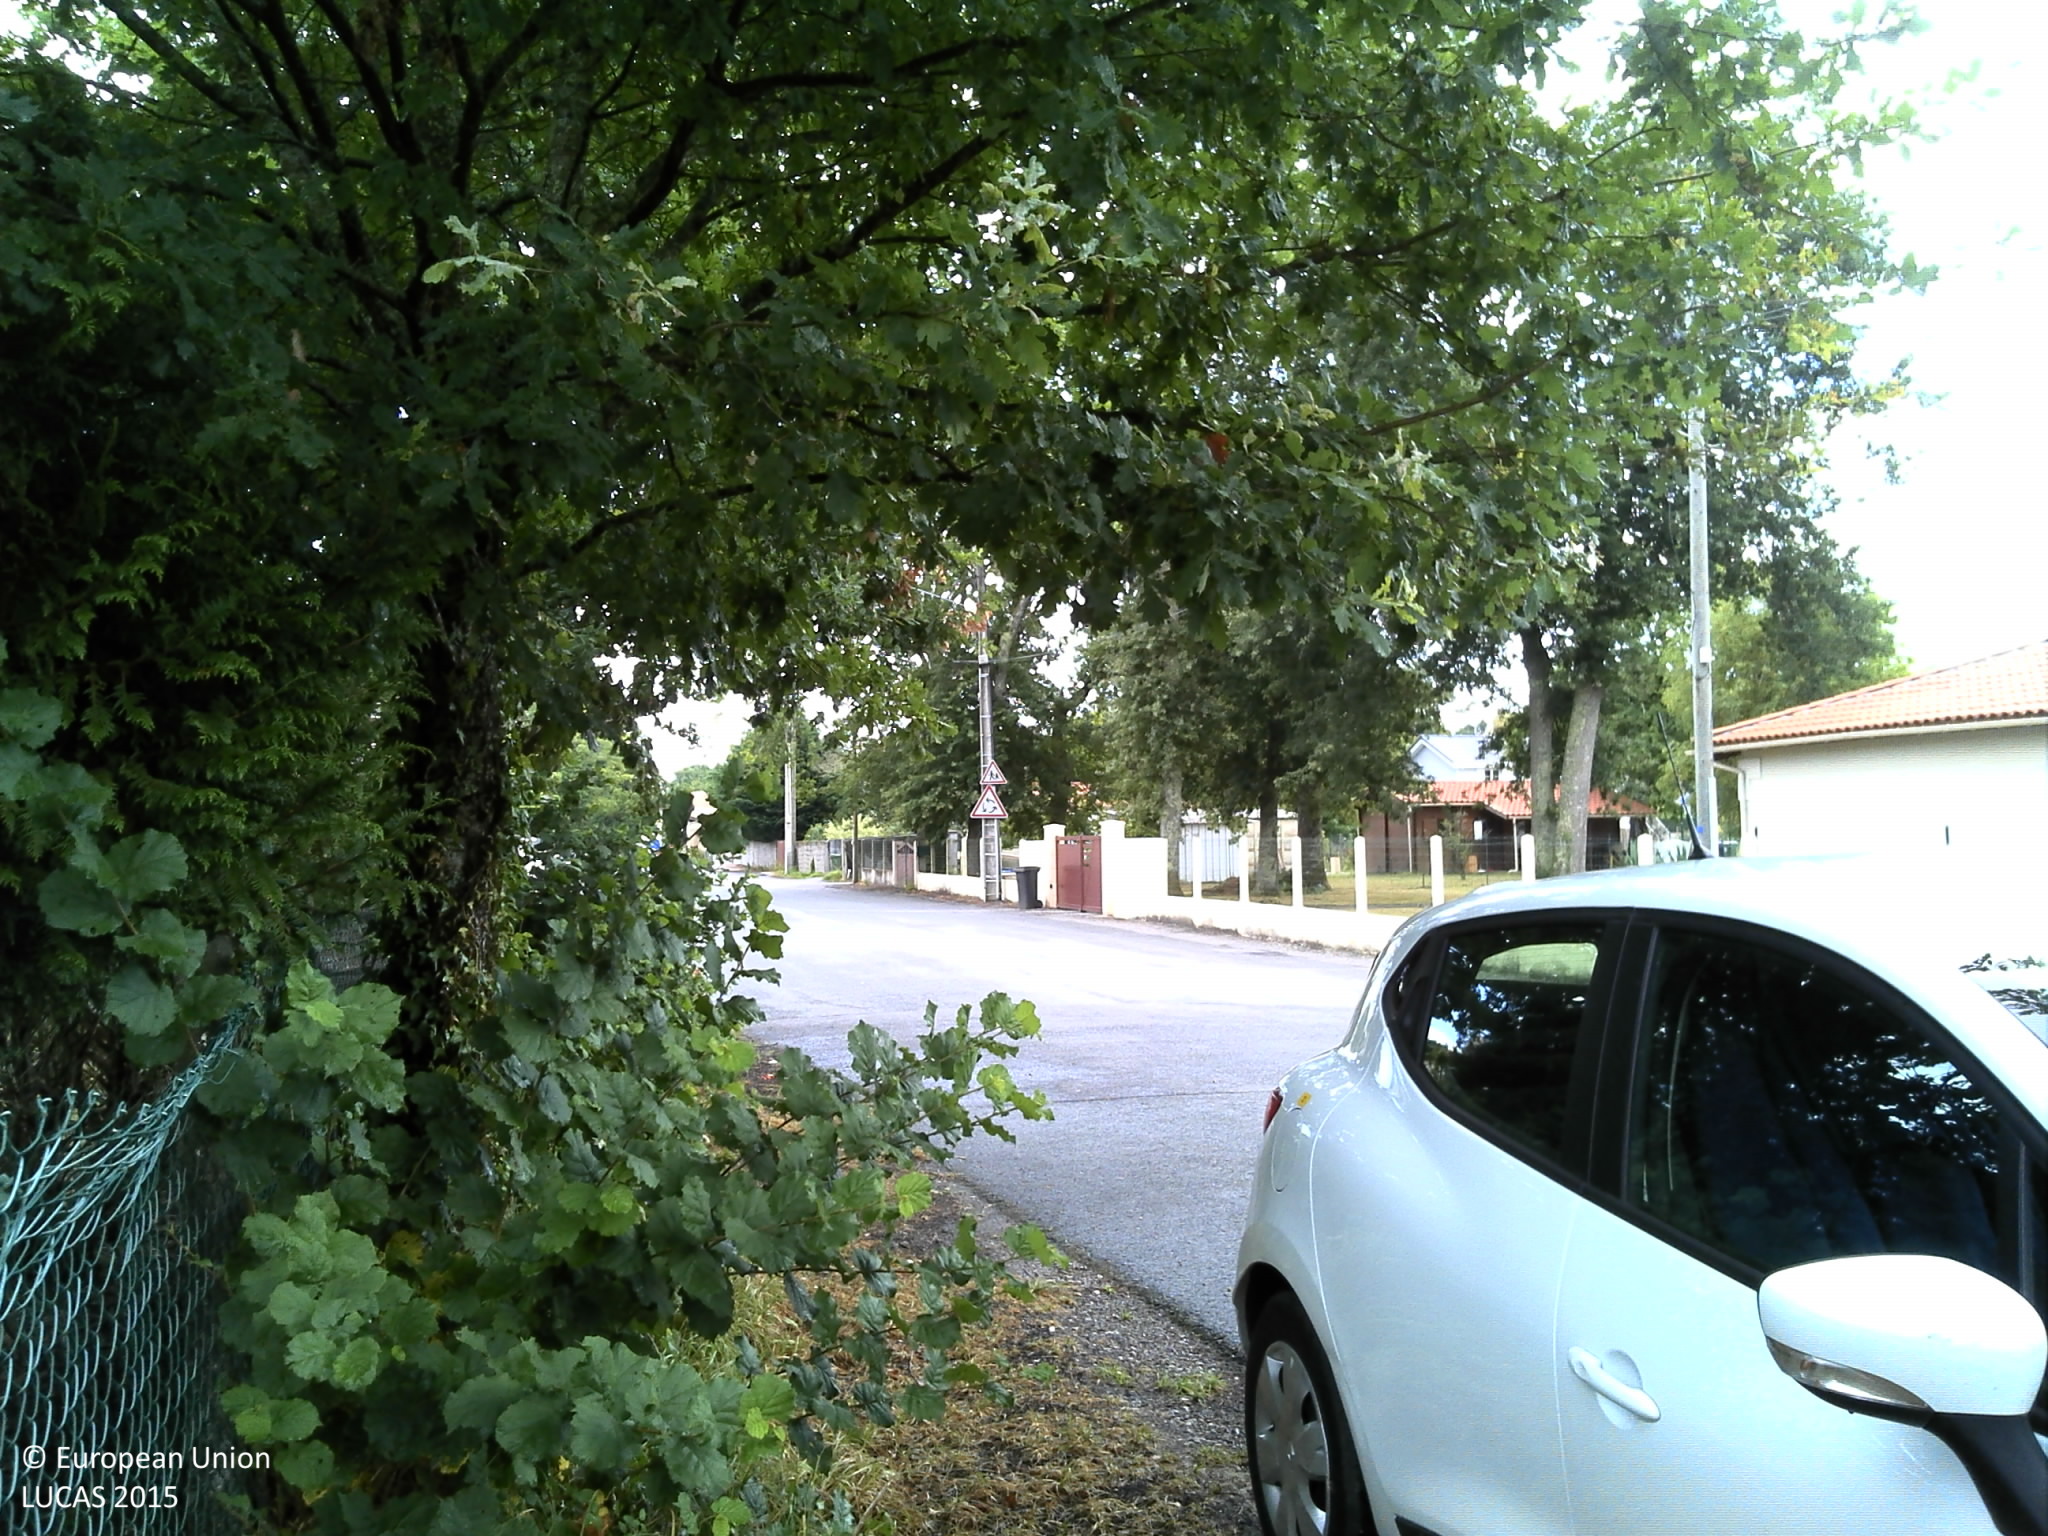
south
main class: Grassland
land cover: Grassland without tree/shrub cover
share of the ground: > 75 %
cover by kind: herbaceous plants 100 %
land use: Residential
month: July
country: FR
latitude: 44.7546
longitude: -0.7442
